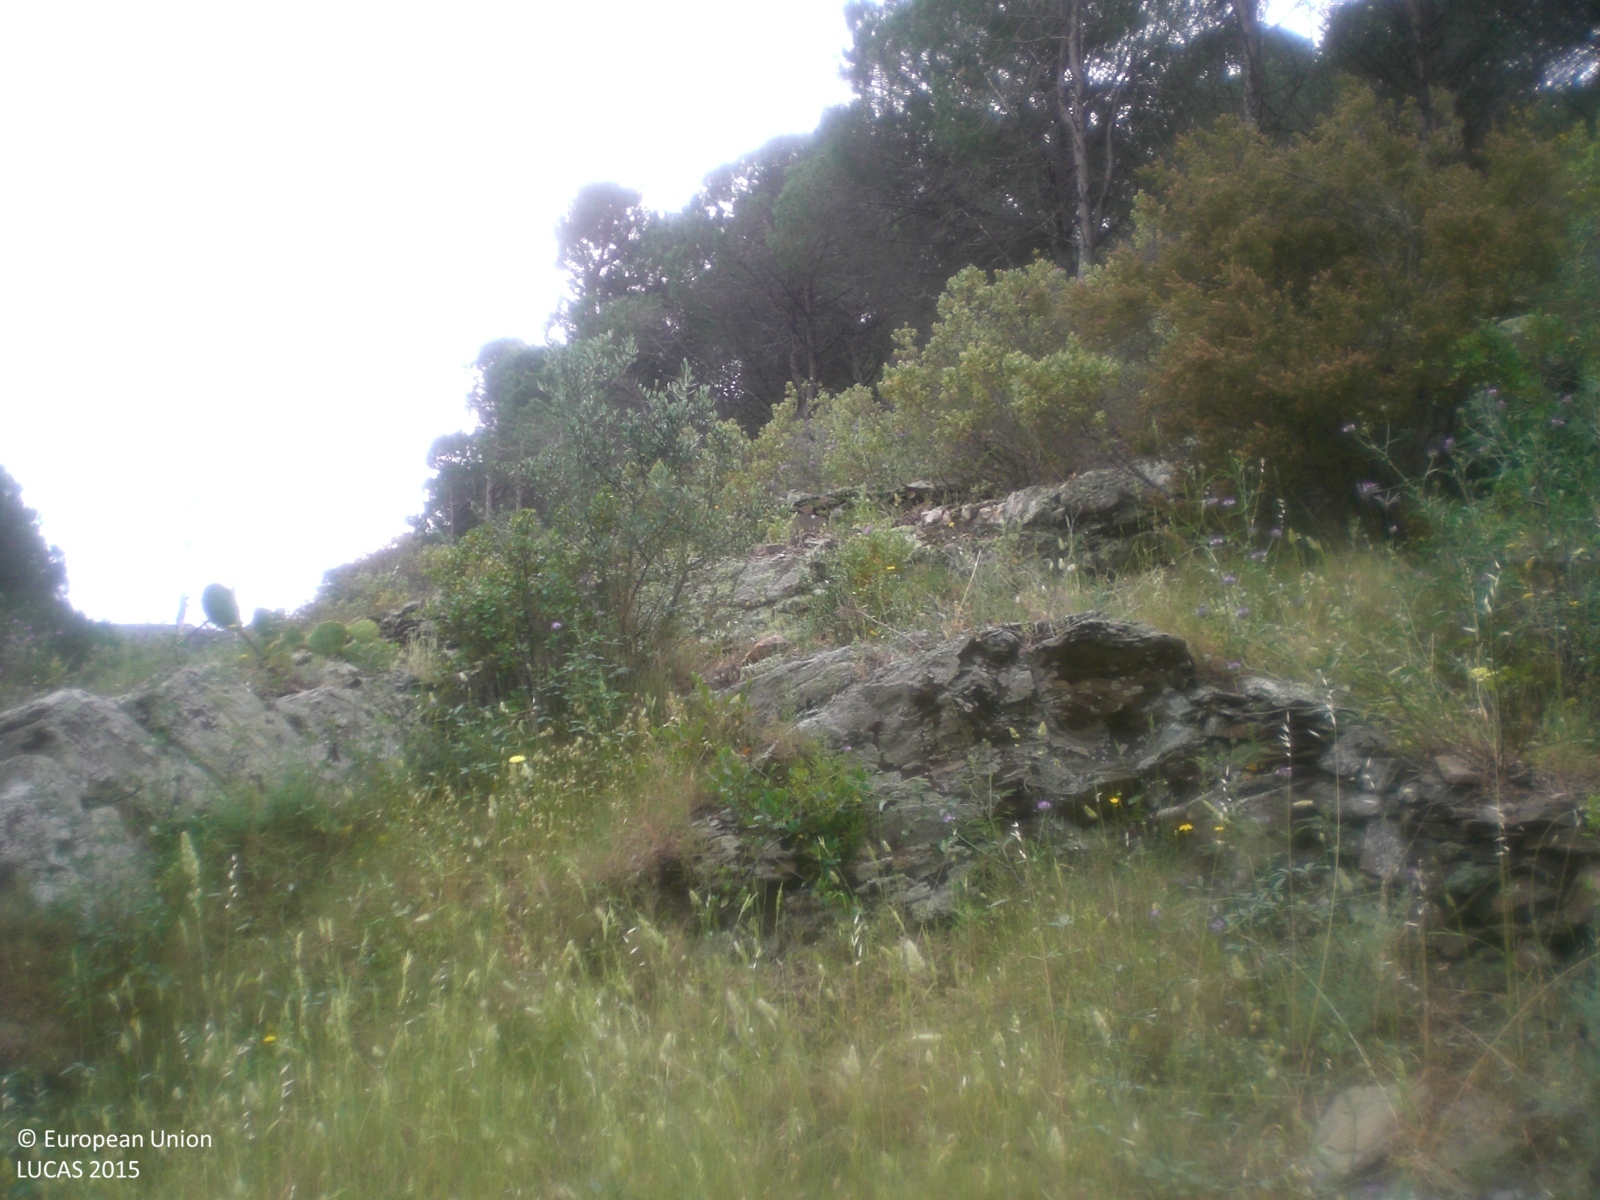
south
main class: Woodland
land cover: Pine dominated mixed woodland
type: coniferous forest of the mediterranean region
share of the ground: 10 - 25 %
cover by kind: herbaceous plants 30 %, coniferous forest trees 25 %, shrubs 25 %, broadleaved forest trees 10 %, consolidated bare surface 10 %
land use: Forestry
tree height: > 5 m
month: May
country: ES
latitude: 42.3171
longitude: 3.2075
